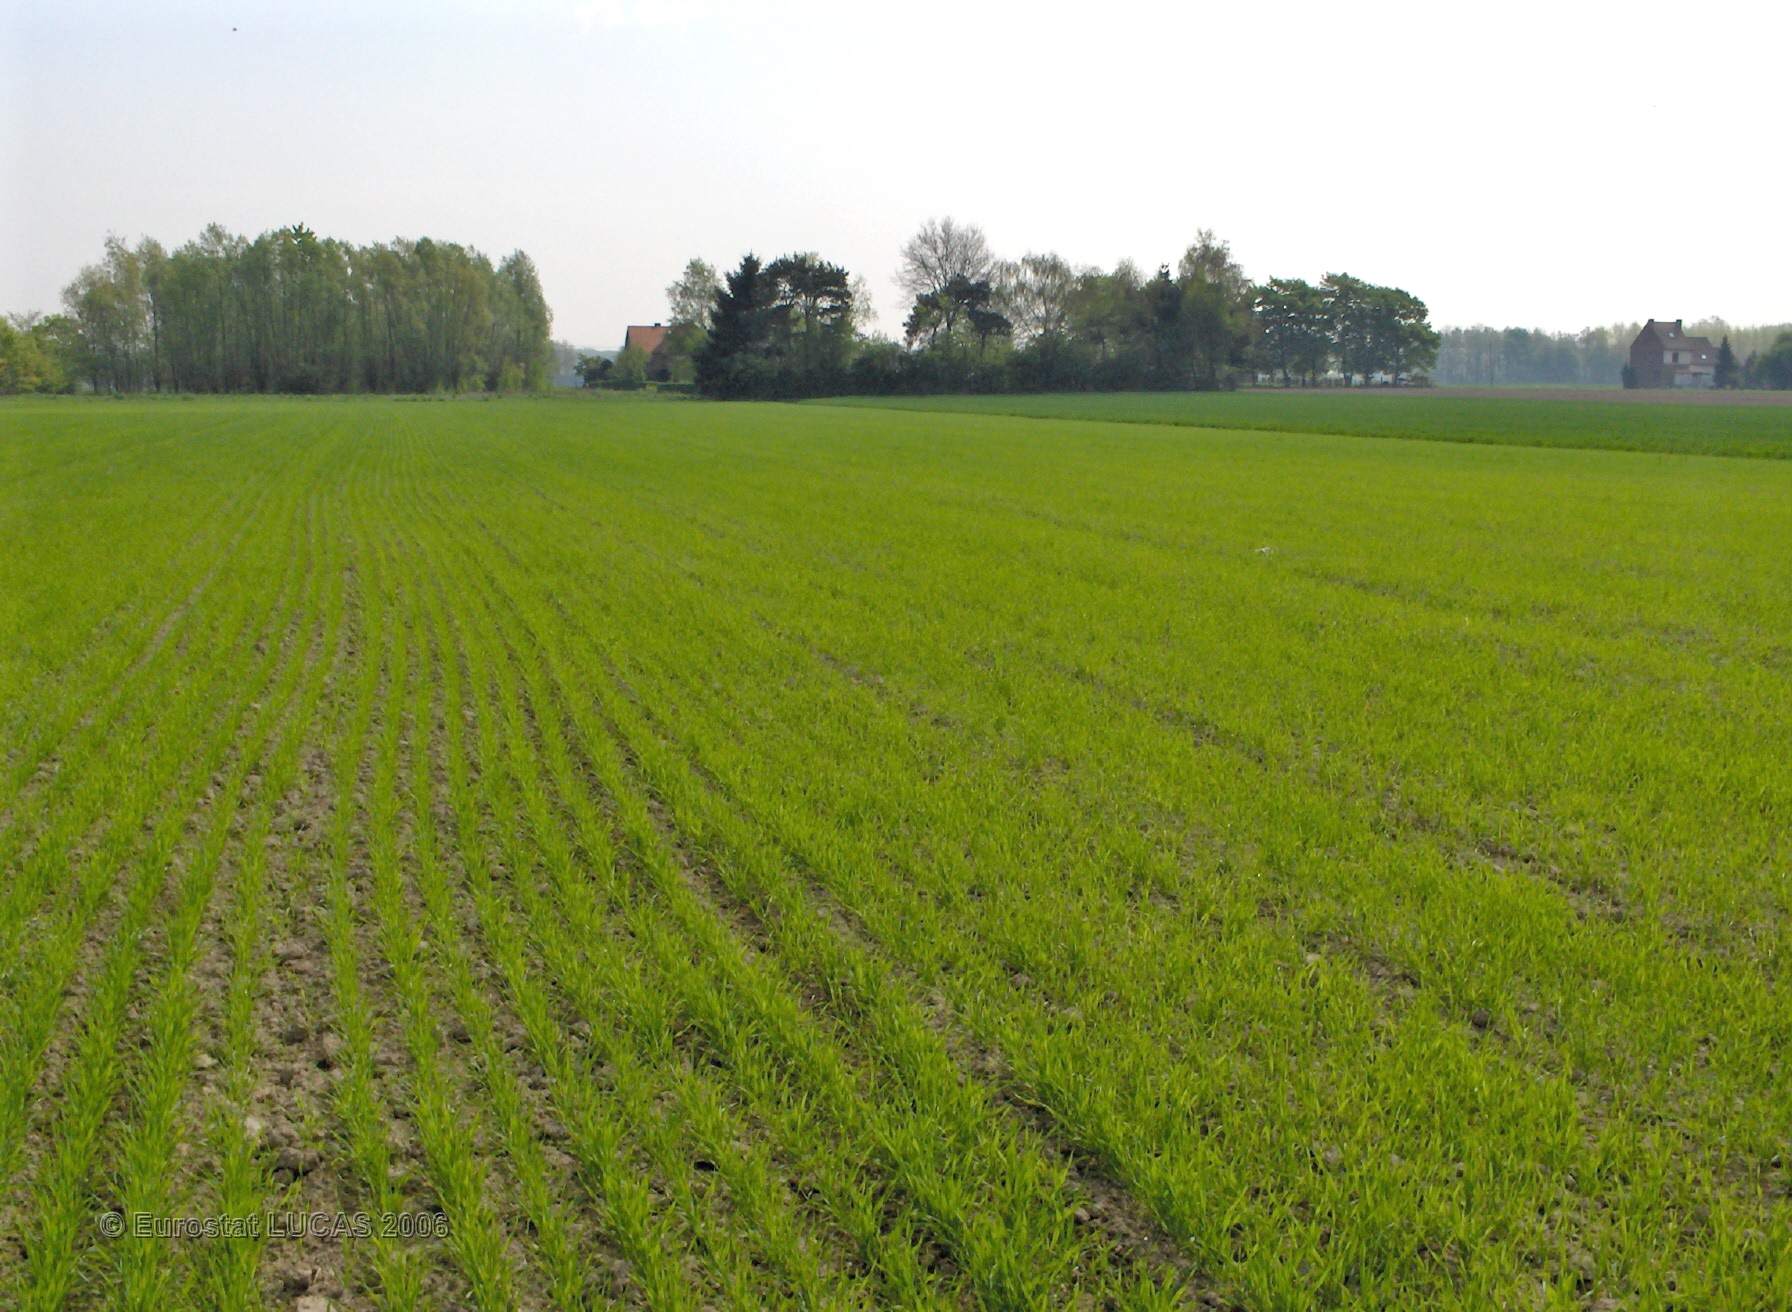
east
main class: Cropland
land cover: Common wheat
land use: Agriculture (excluding fallow land and kitchen gardens)
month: May
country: BE
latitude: 50.9520
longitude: 4.4868
